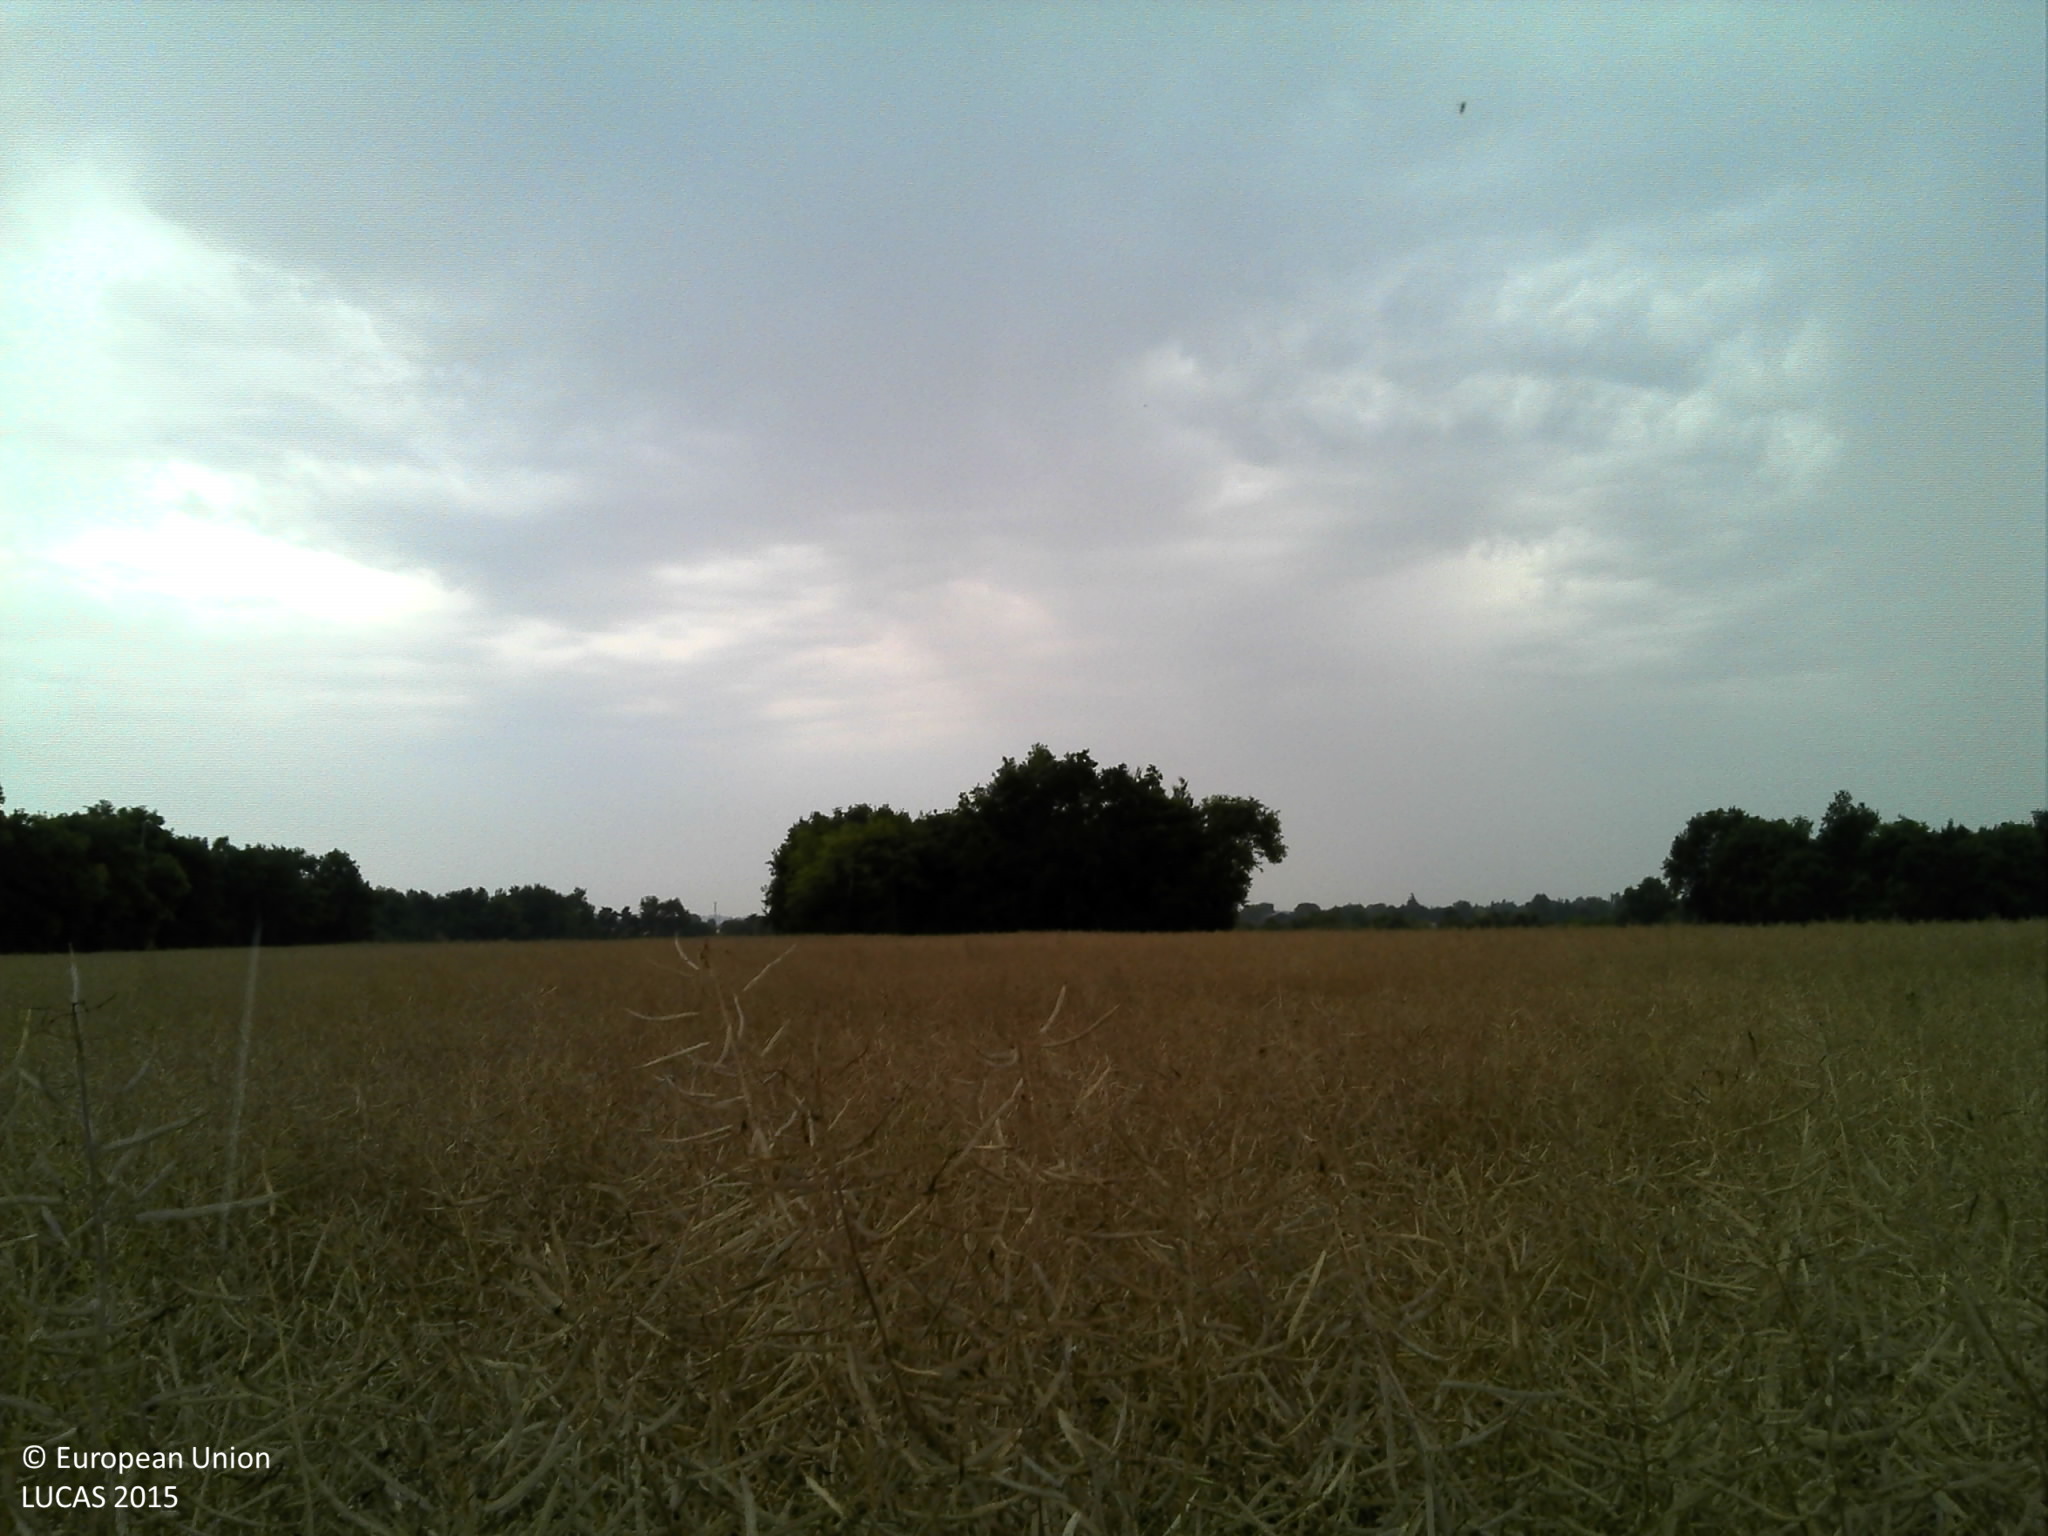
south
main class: Cropland
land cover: Rape and turnip rape
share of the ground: > 75 %
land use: Agriculture (excluding fallow land and kitchen gardens)
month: July
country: FR
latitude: 48.2919
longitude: 2.4821
